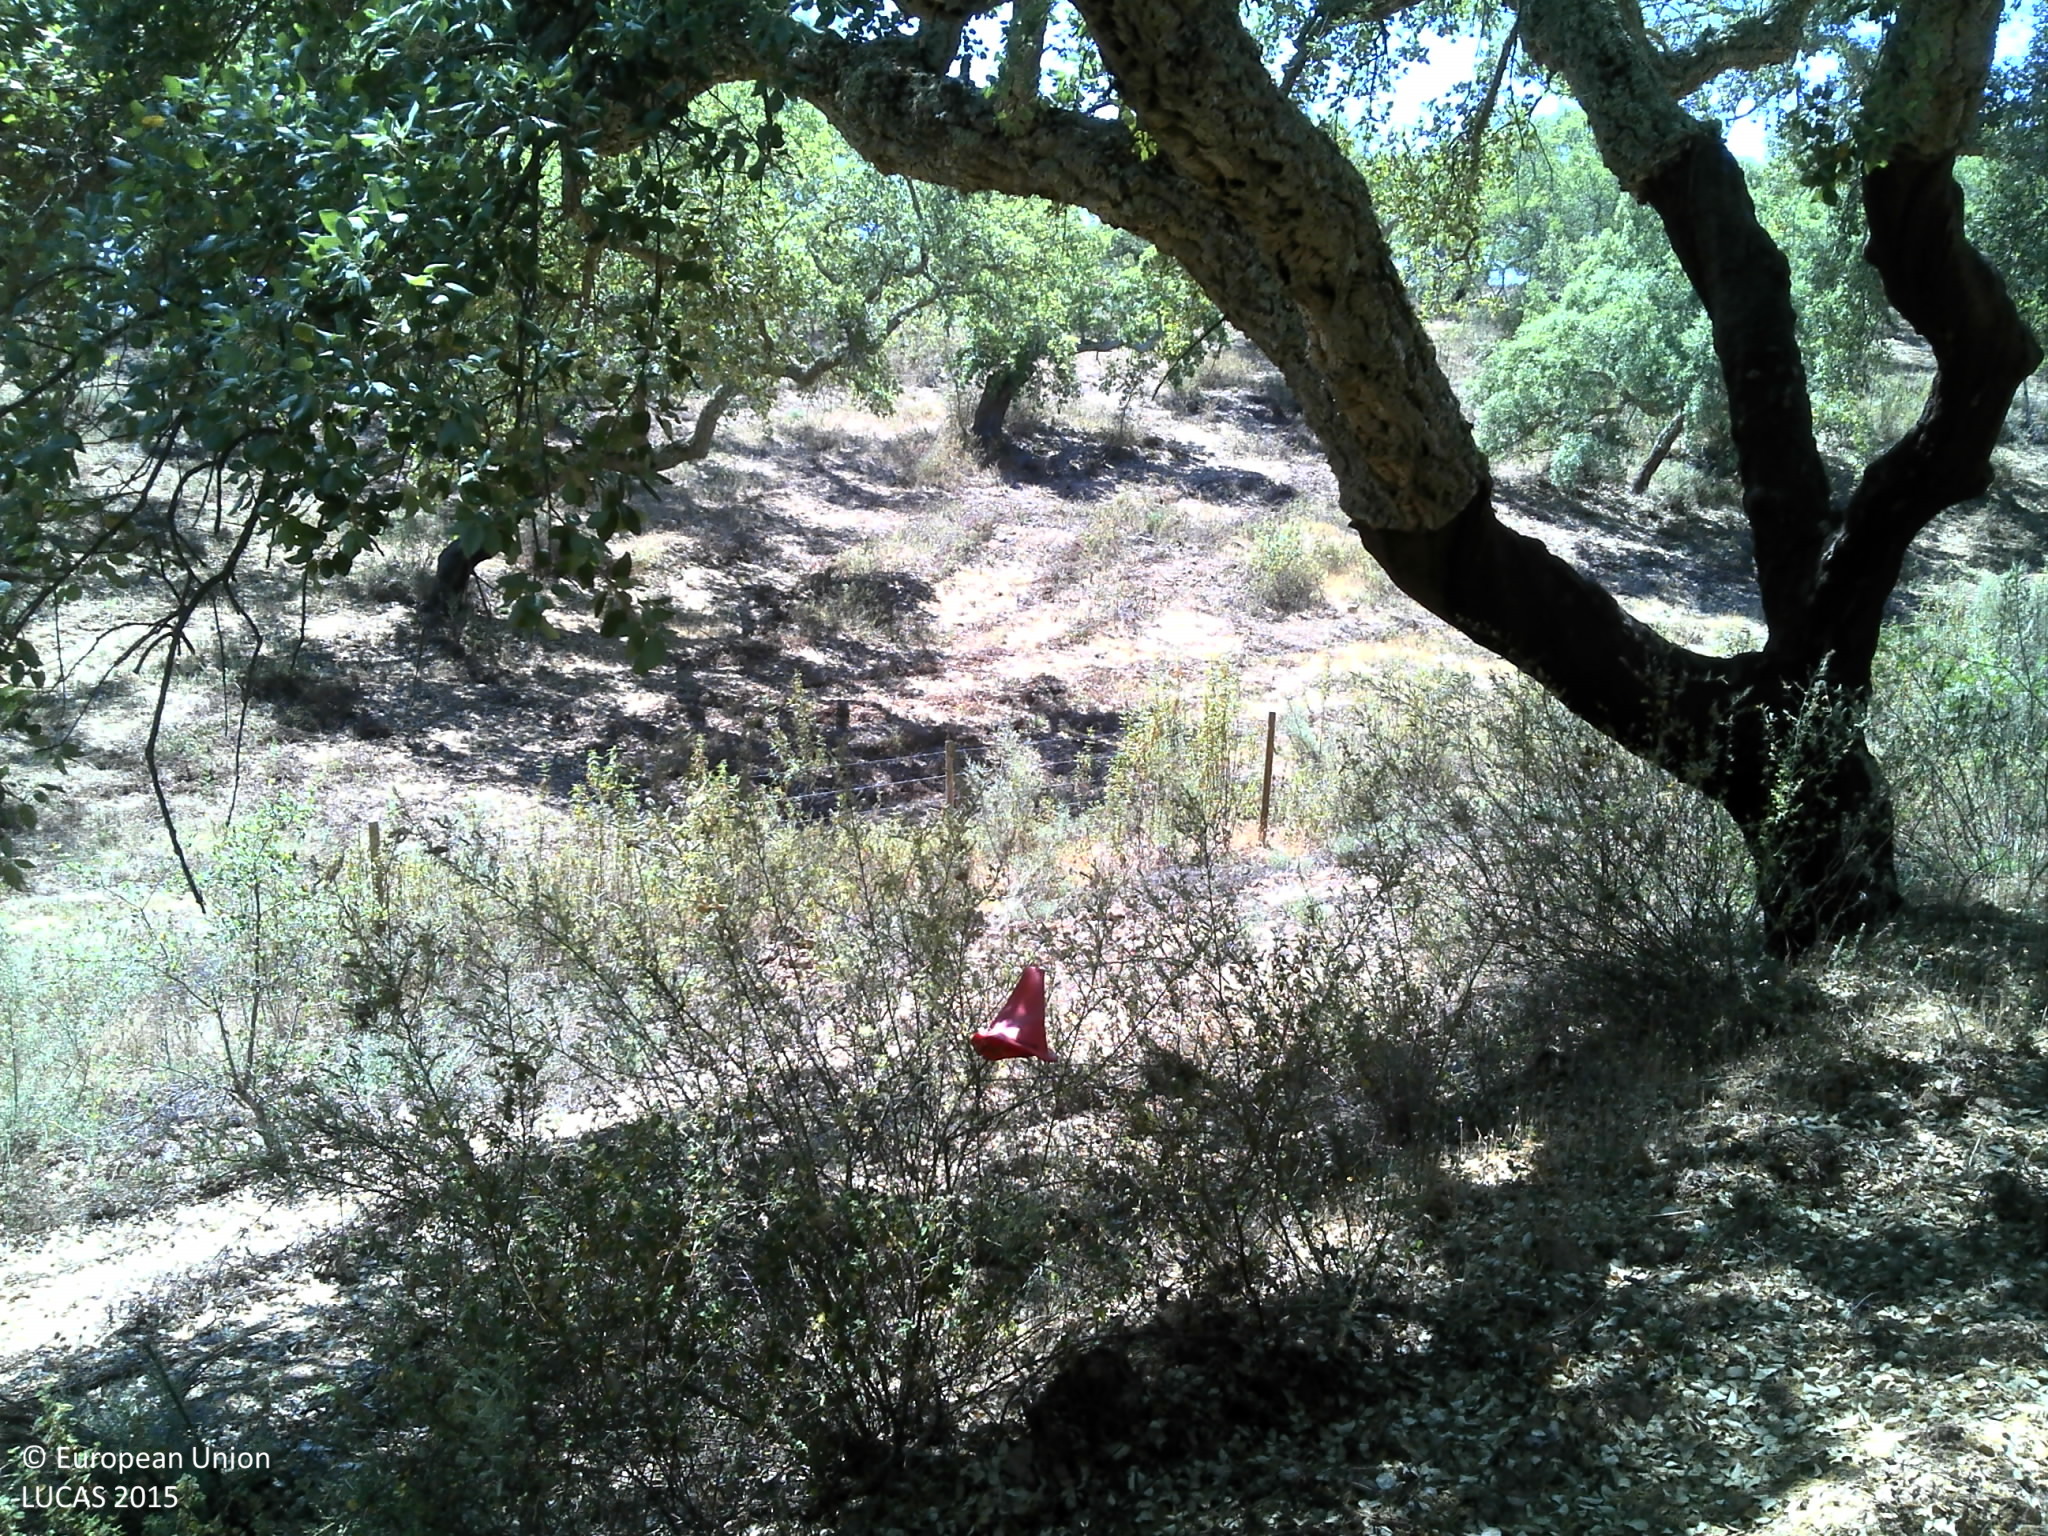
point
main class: Woodland
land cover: Broadleaved woodland
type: broadleaved evergreen forest
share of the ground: 25 - 50 %
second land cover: Grassland without tree/shrub cover
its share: 10 - 25 %
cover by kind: broadleaved forest trees 50 %, unconsolidated bare surface 35 %, herbaceous plants 15 %
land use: Forestry
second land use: Agriculture (excluding fallow land and kitchen gardens)
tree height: > 5 m
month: June
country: PT
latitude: 38.7851
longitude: -7.7332
